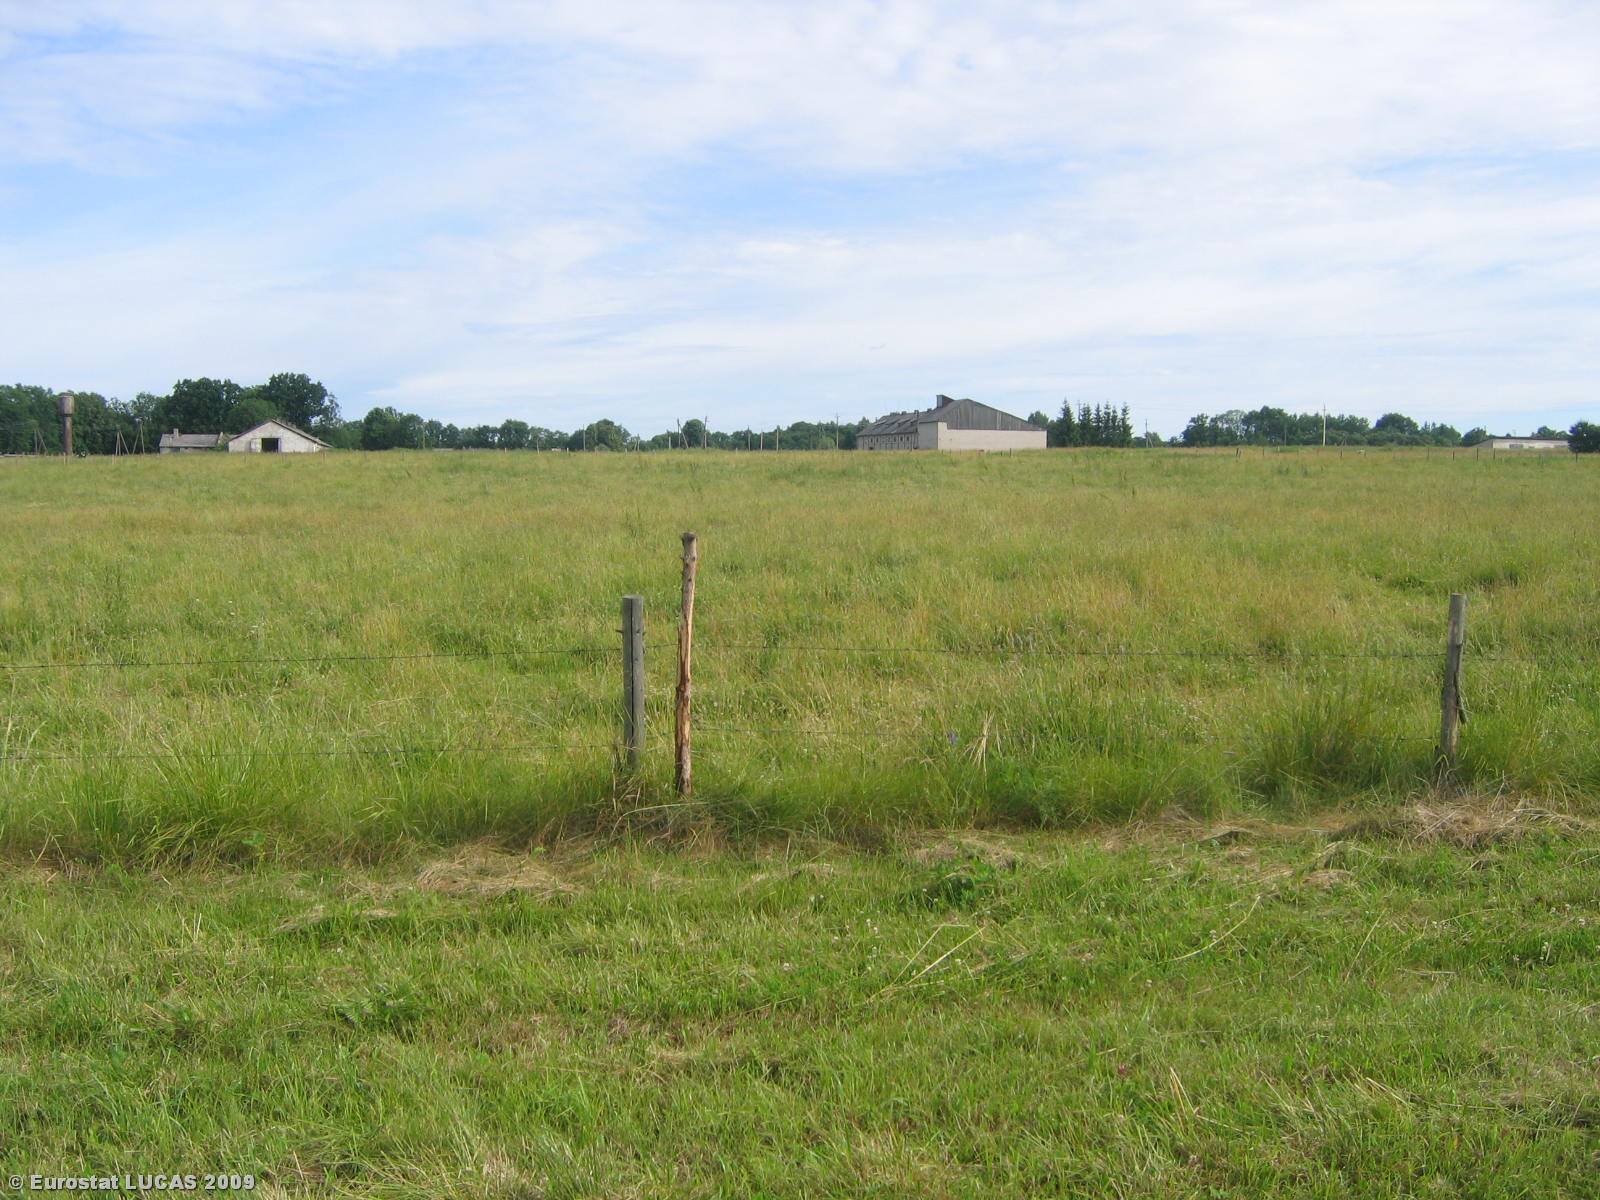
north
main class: Grassland
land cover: Grassland without tree/shrub cover
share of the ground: > 75 %
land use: Agriculture (excluding fallow land and kitchen gardens)
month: July
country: LT
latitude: 55.3387
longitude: 22.6615
